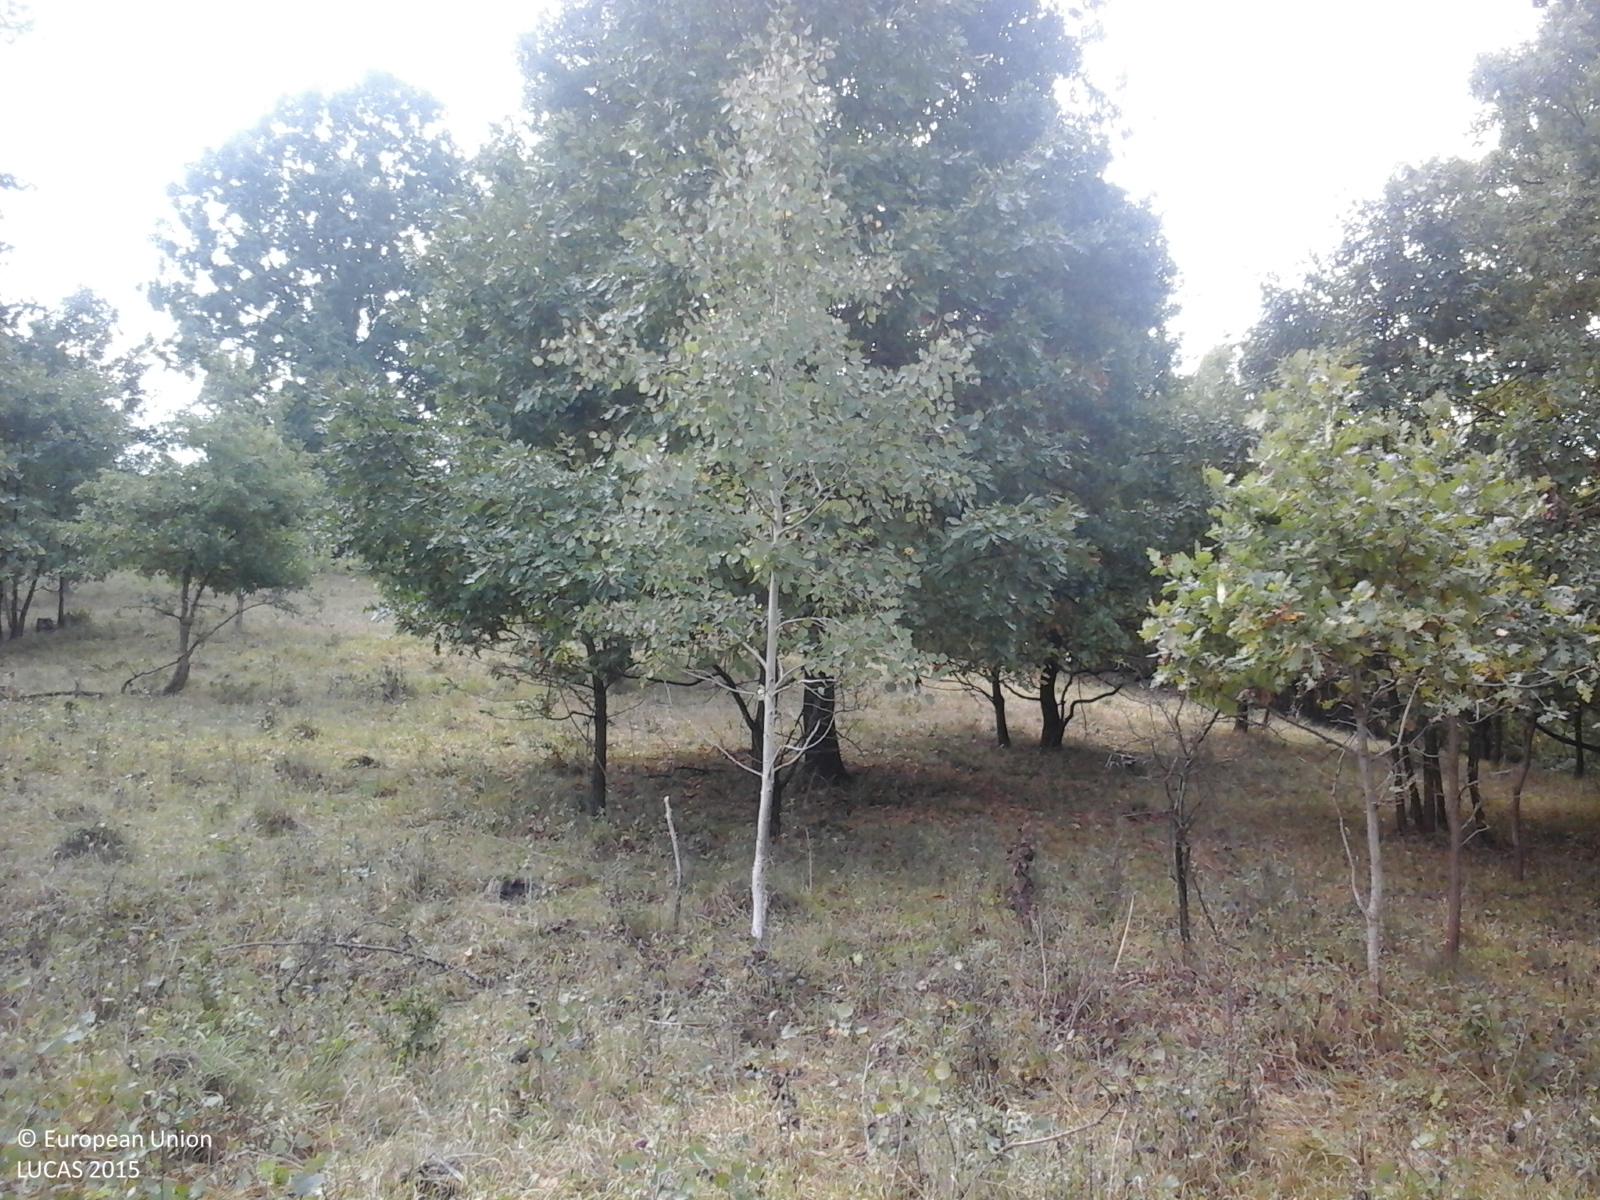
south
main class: Grassland
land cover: Grassland with sparse tree/shrub cover
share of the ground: > 75 %
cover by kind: herbaceous plants 85 %, shrubs 10 %, broadleaved forest trees 5 %
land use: Agriculture (excluding fallow land and kitchen gardens)
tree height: > 5 m
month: September
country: RO
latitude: 45.6784
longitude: 22.8776
